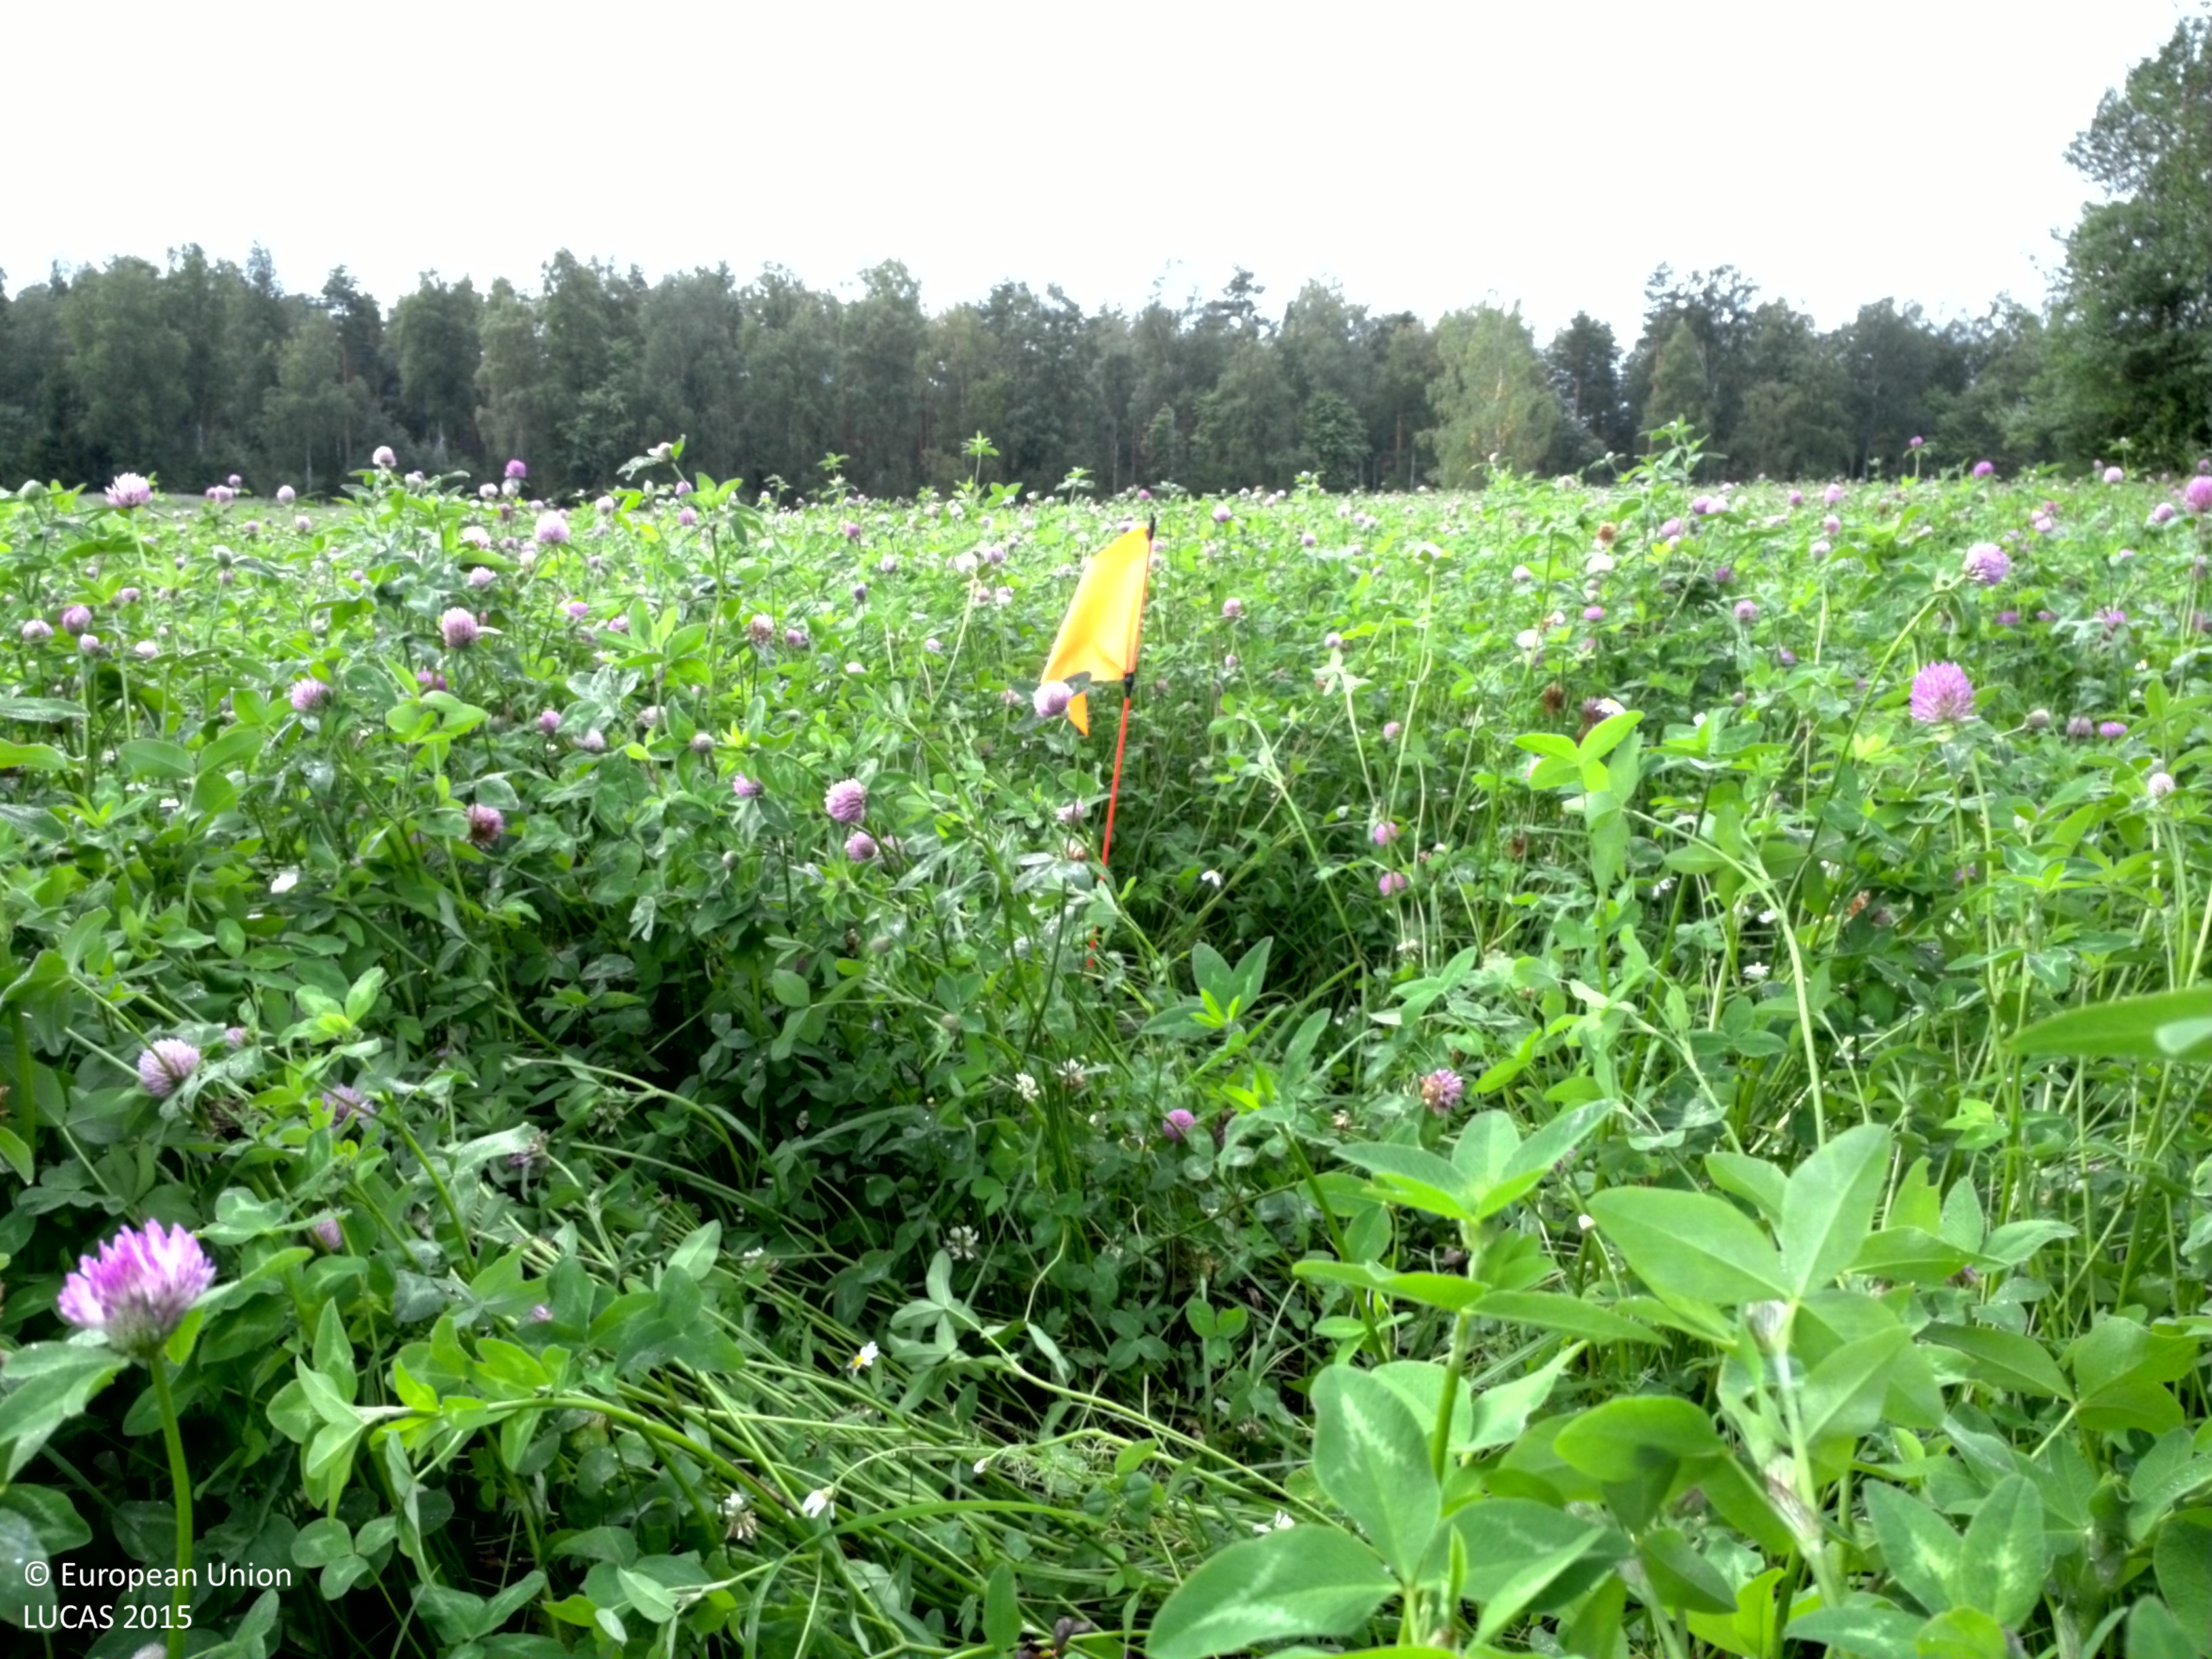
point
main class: Cropland
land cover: Clovers
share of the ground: > 75 %
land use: Agriculture (excluding fallow land and kitchen gardens)
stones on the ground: < 10 %
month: August
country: SE
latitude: 59.9264
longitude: 16.4134
